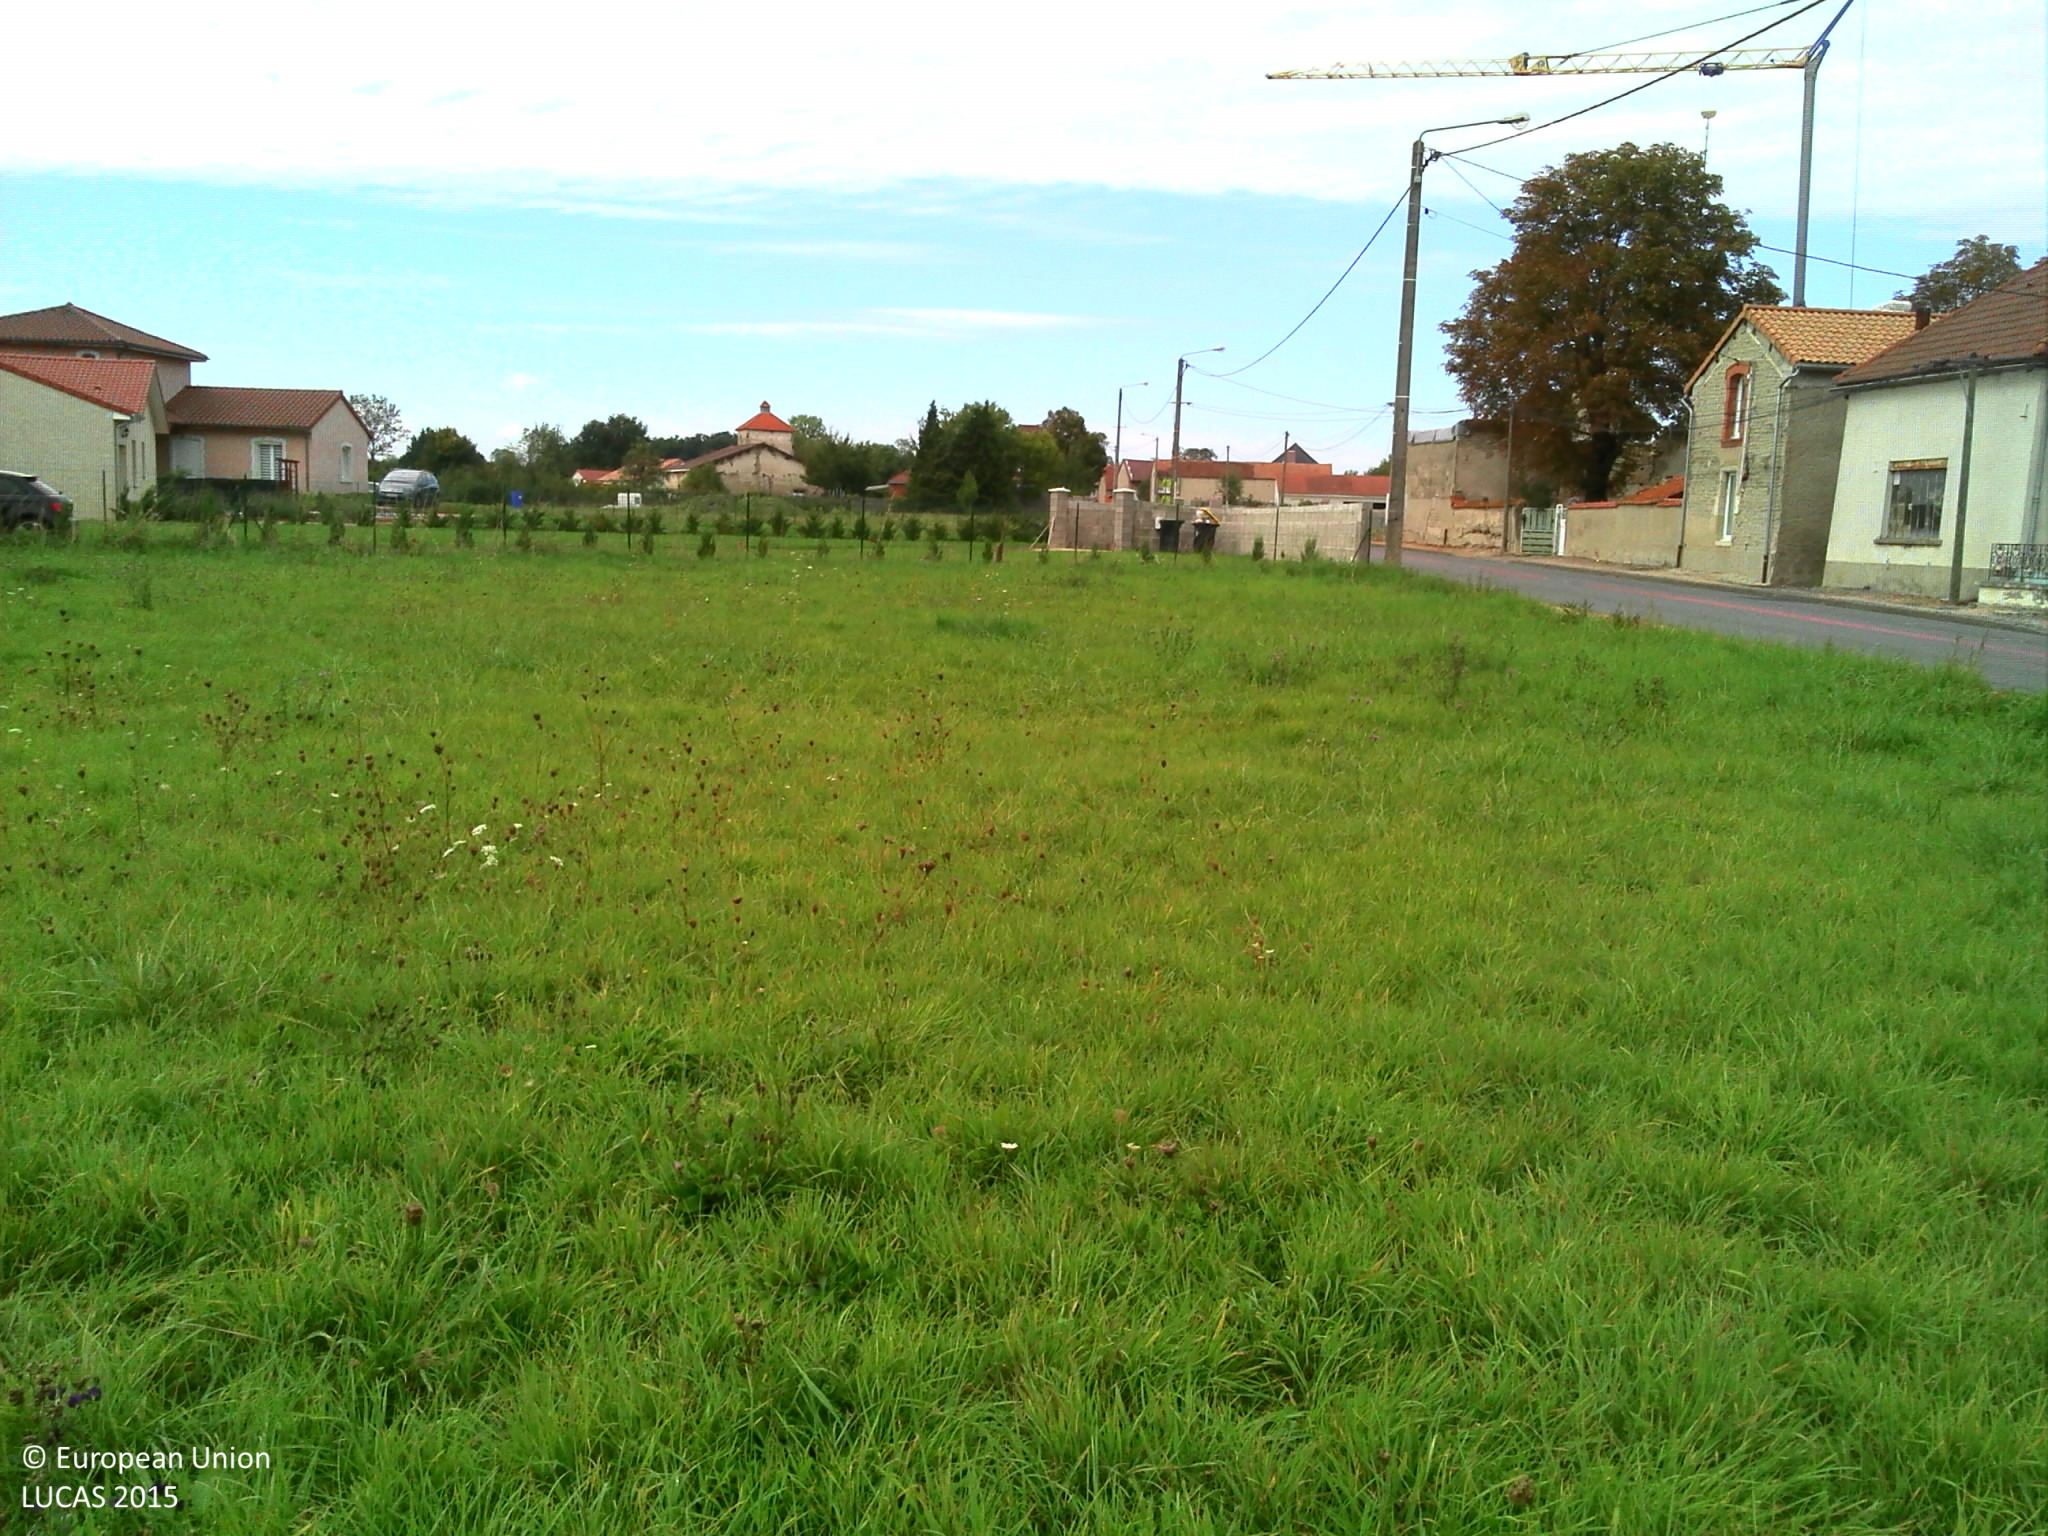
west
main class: Grassland
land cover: Grassland without tree/shrub cover
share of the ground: > 75 %
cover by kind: herbaceous plants 100 %
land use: Agriculture (excluding fallow land and kitchen gardens)
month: October
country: FR
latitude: 45.9964
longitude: 3.2986
